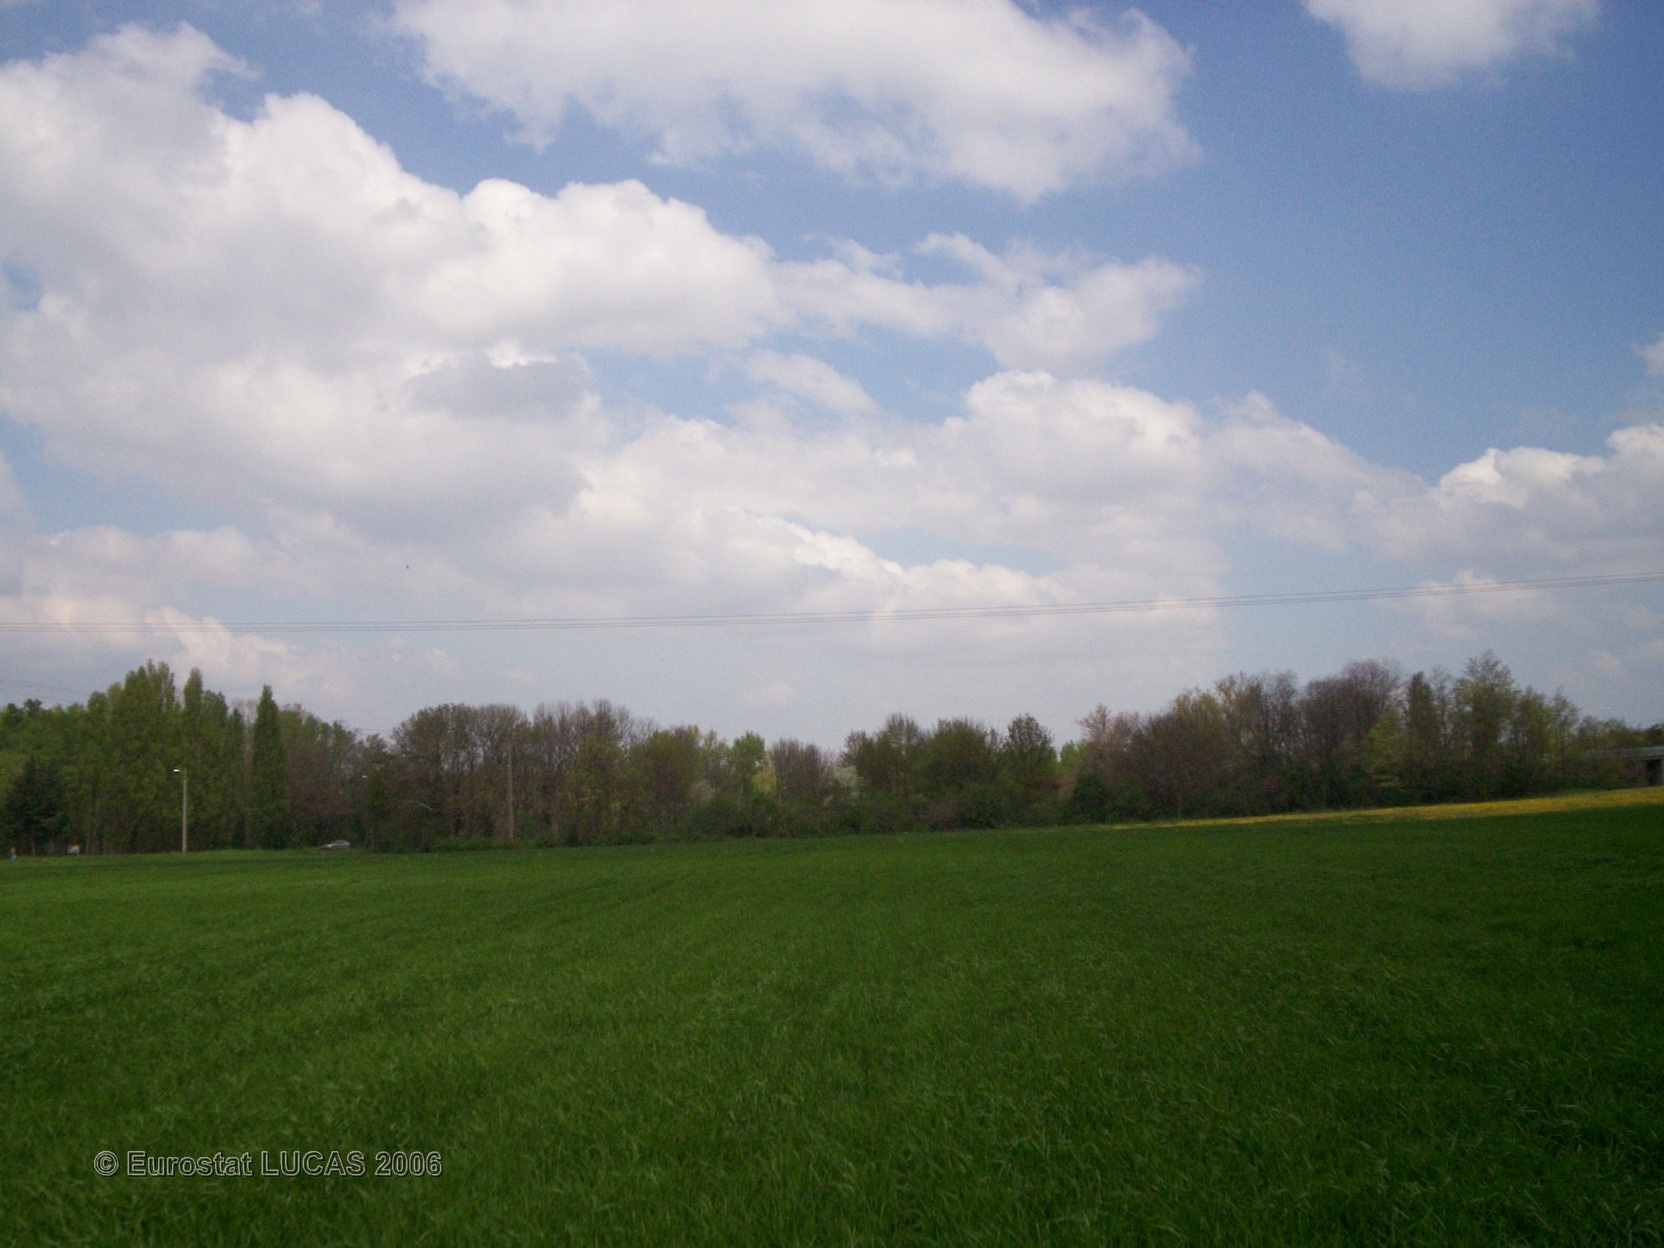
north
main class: Cropland
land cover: Barley
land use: Agriculture (excluding fallow land and kitchen gardens)
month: April
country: FR
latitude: 44.9105
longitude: 4.8760
